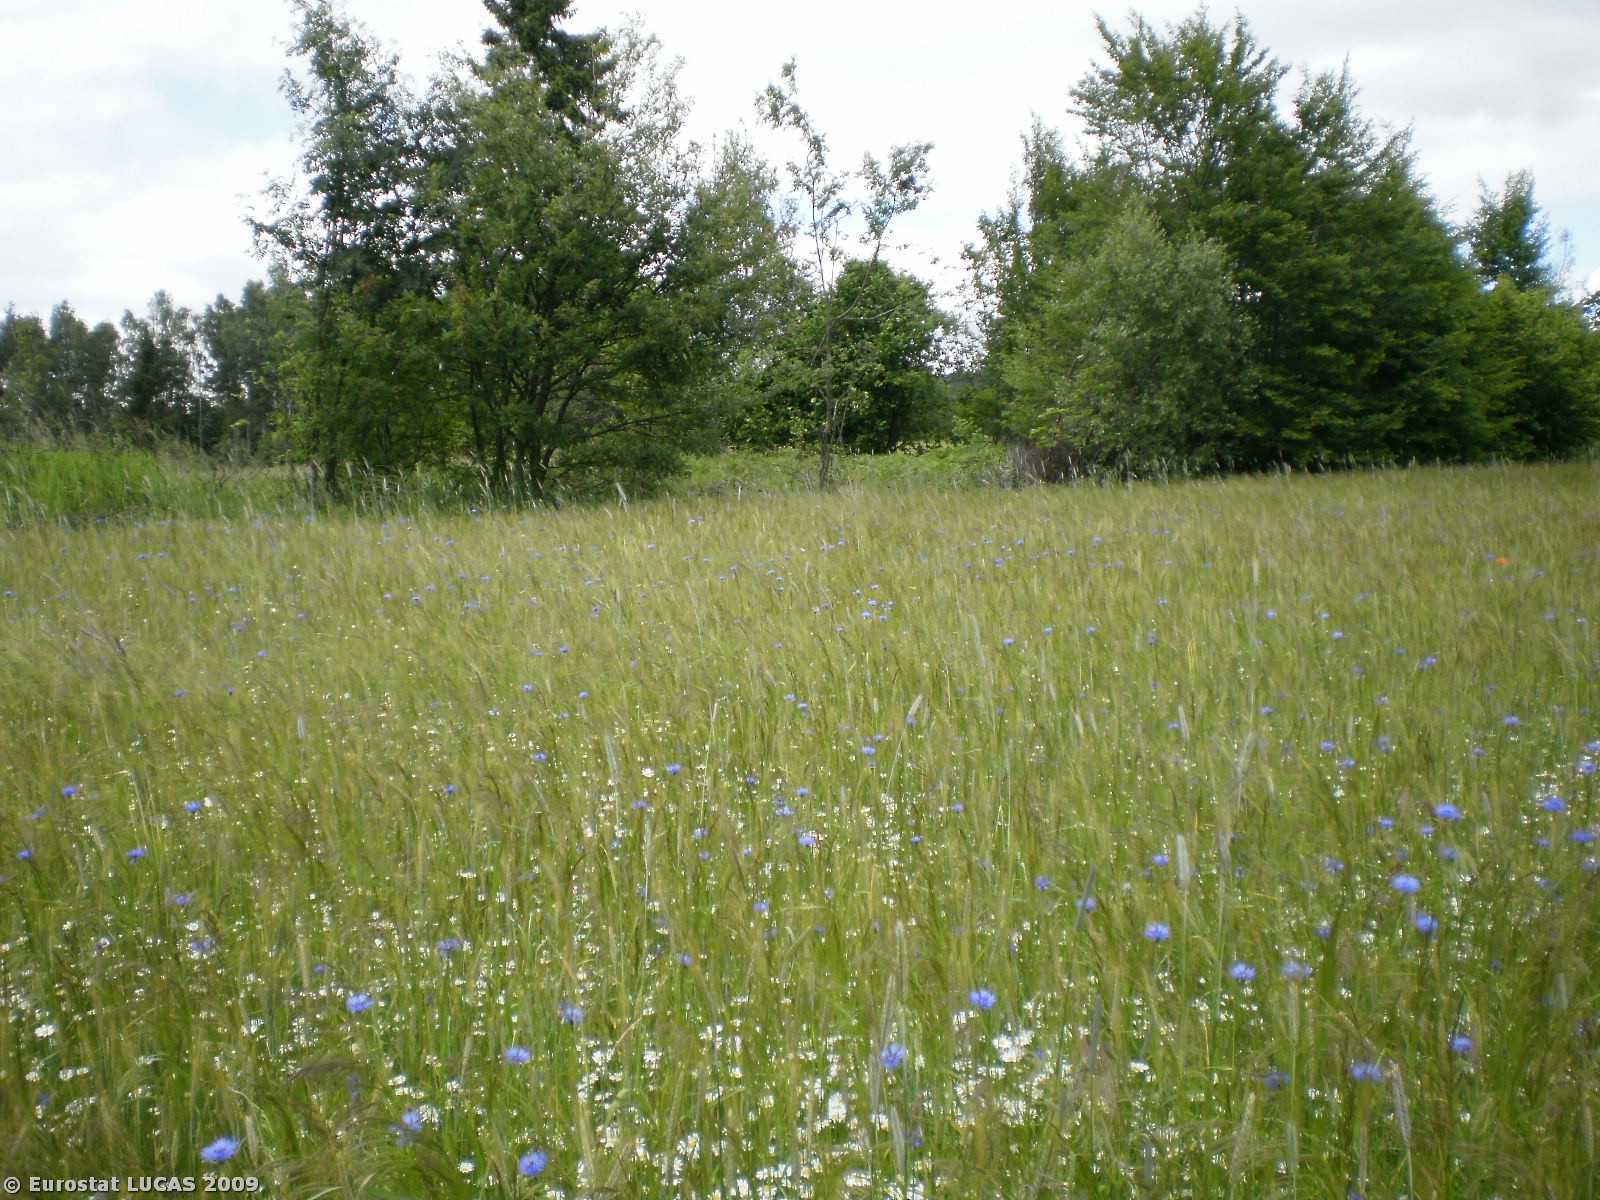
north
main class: Cropland
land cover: Rye
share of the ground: > 75 %
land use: Agriculture (excluding fallow land and kitchen gardens)
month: June
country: PL
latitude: 54.1950
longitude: 18.1229
